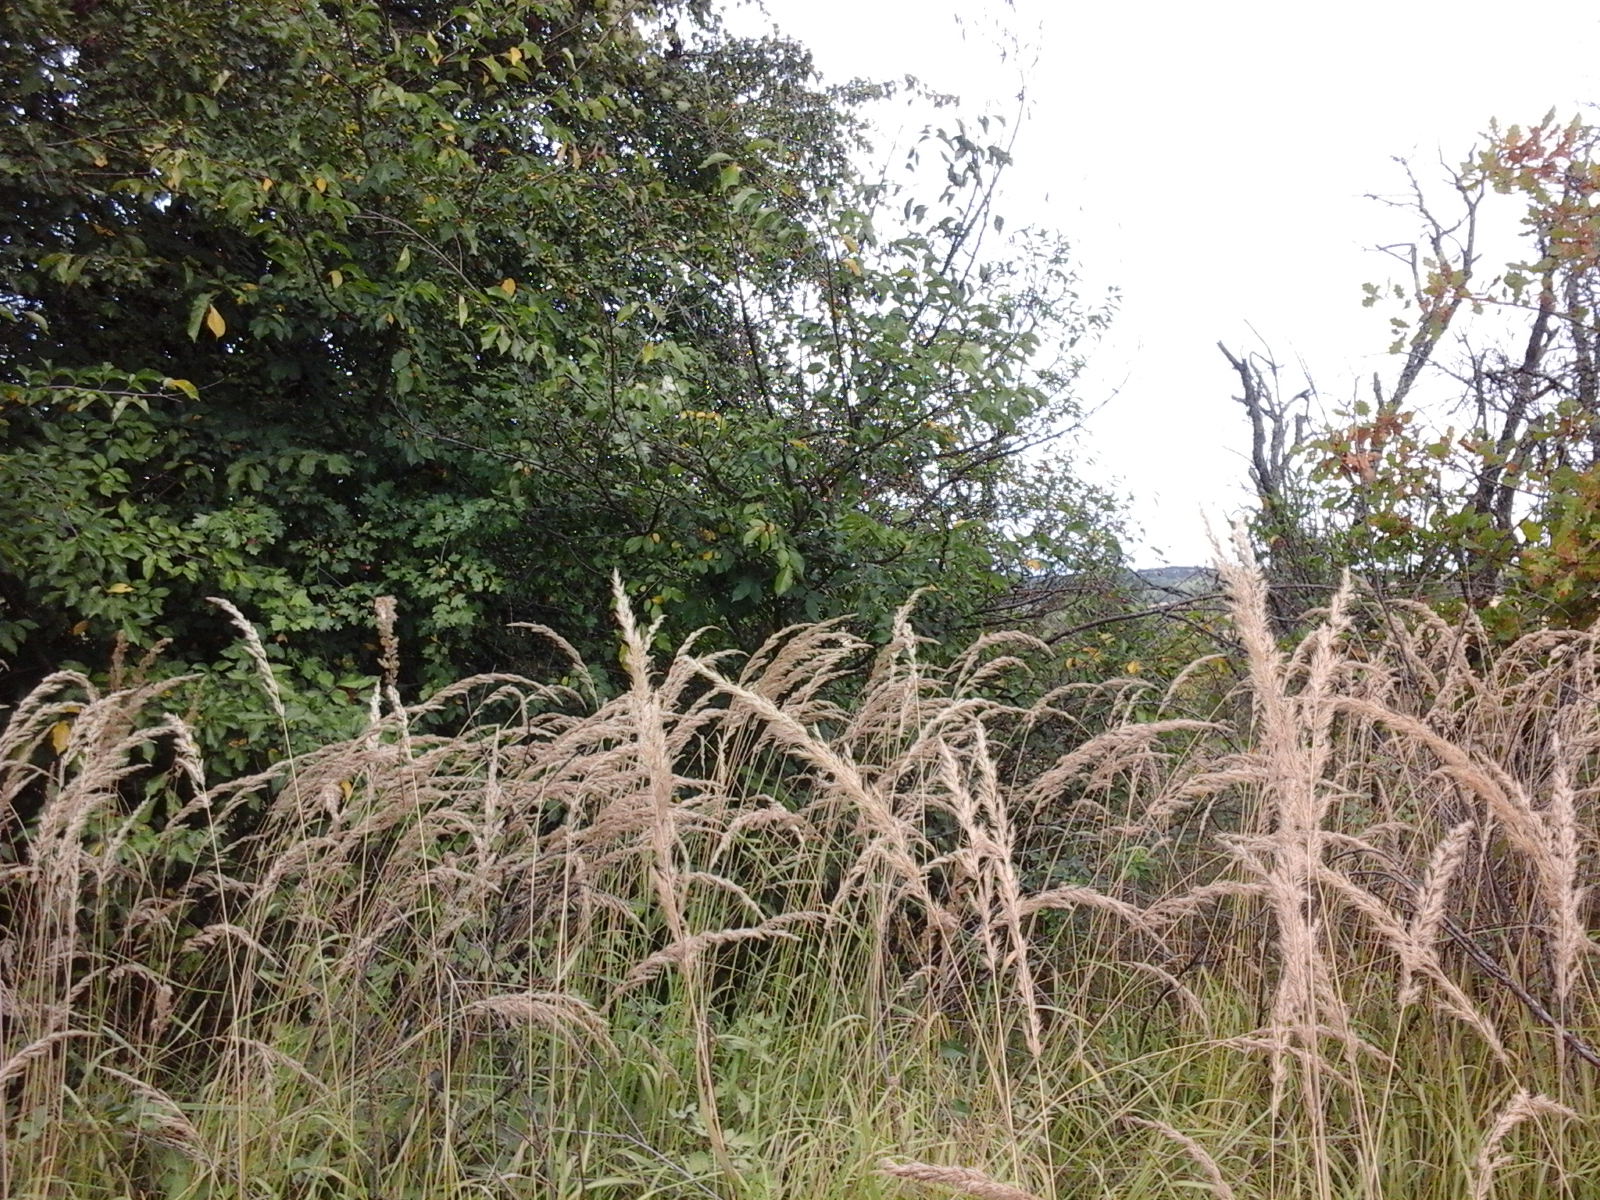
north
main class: Shrubland
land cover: Shrubland with sparse tree cover
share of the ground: > 75 %
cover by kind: shrubs 95 %, broadleaved forest trees 5 %
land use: Semi-natural and natural areas not in use
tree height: > 5 m
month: August
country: RO
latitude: 45.2312
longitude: 21.5585
